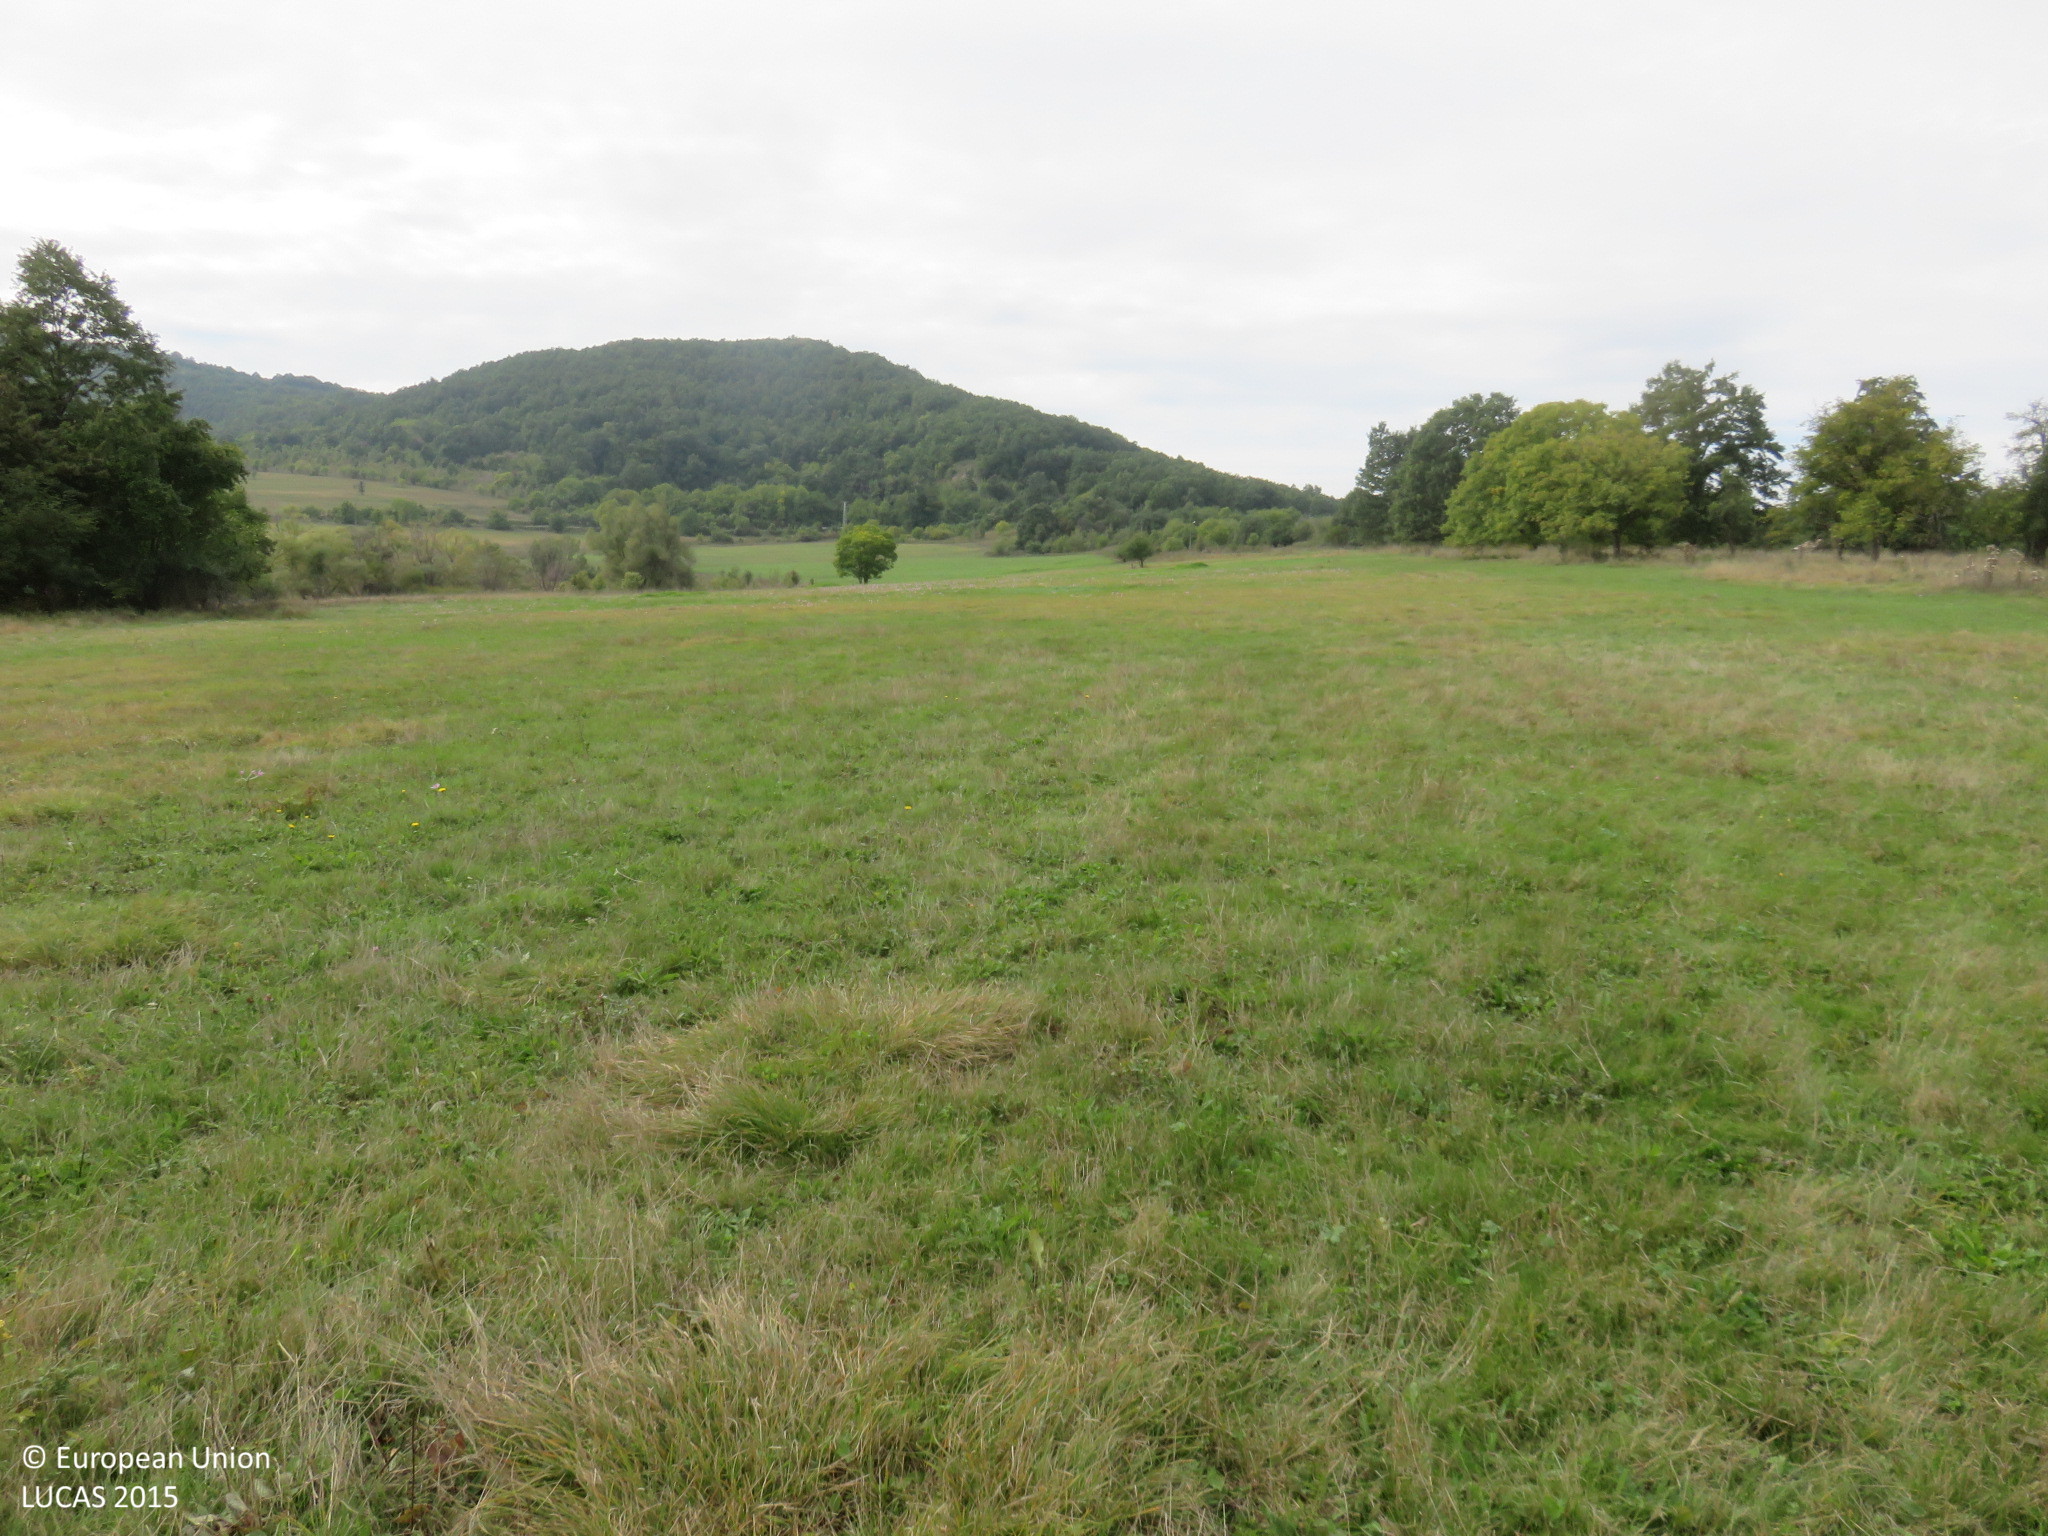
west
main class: Grassland
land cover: Grassland without tree/shrub cover
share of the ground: > 75 %
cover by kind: herbaceous plants 100 %
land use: Agriculture (excluding fallow land and kitchen gardens)
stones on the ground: < 10 %
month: October
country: BG
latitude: 43.0399
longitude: 24.8294
